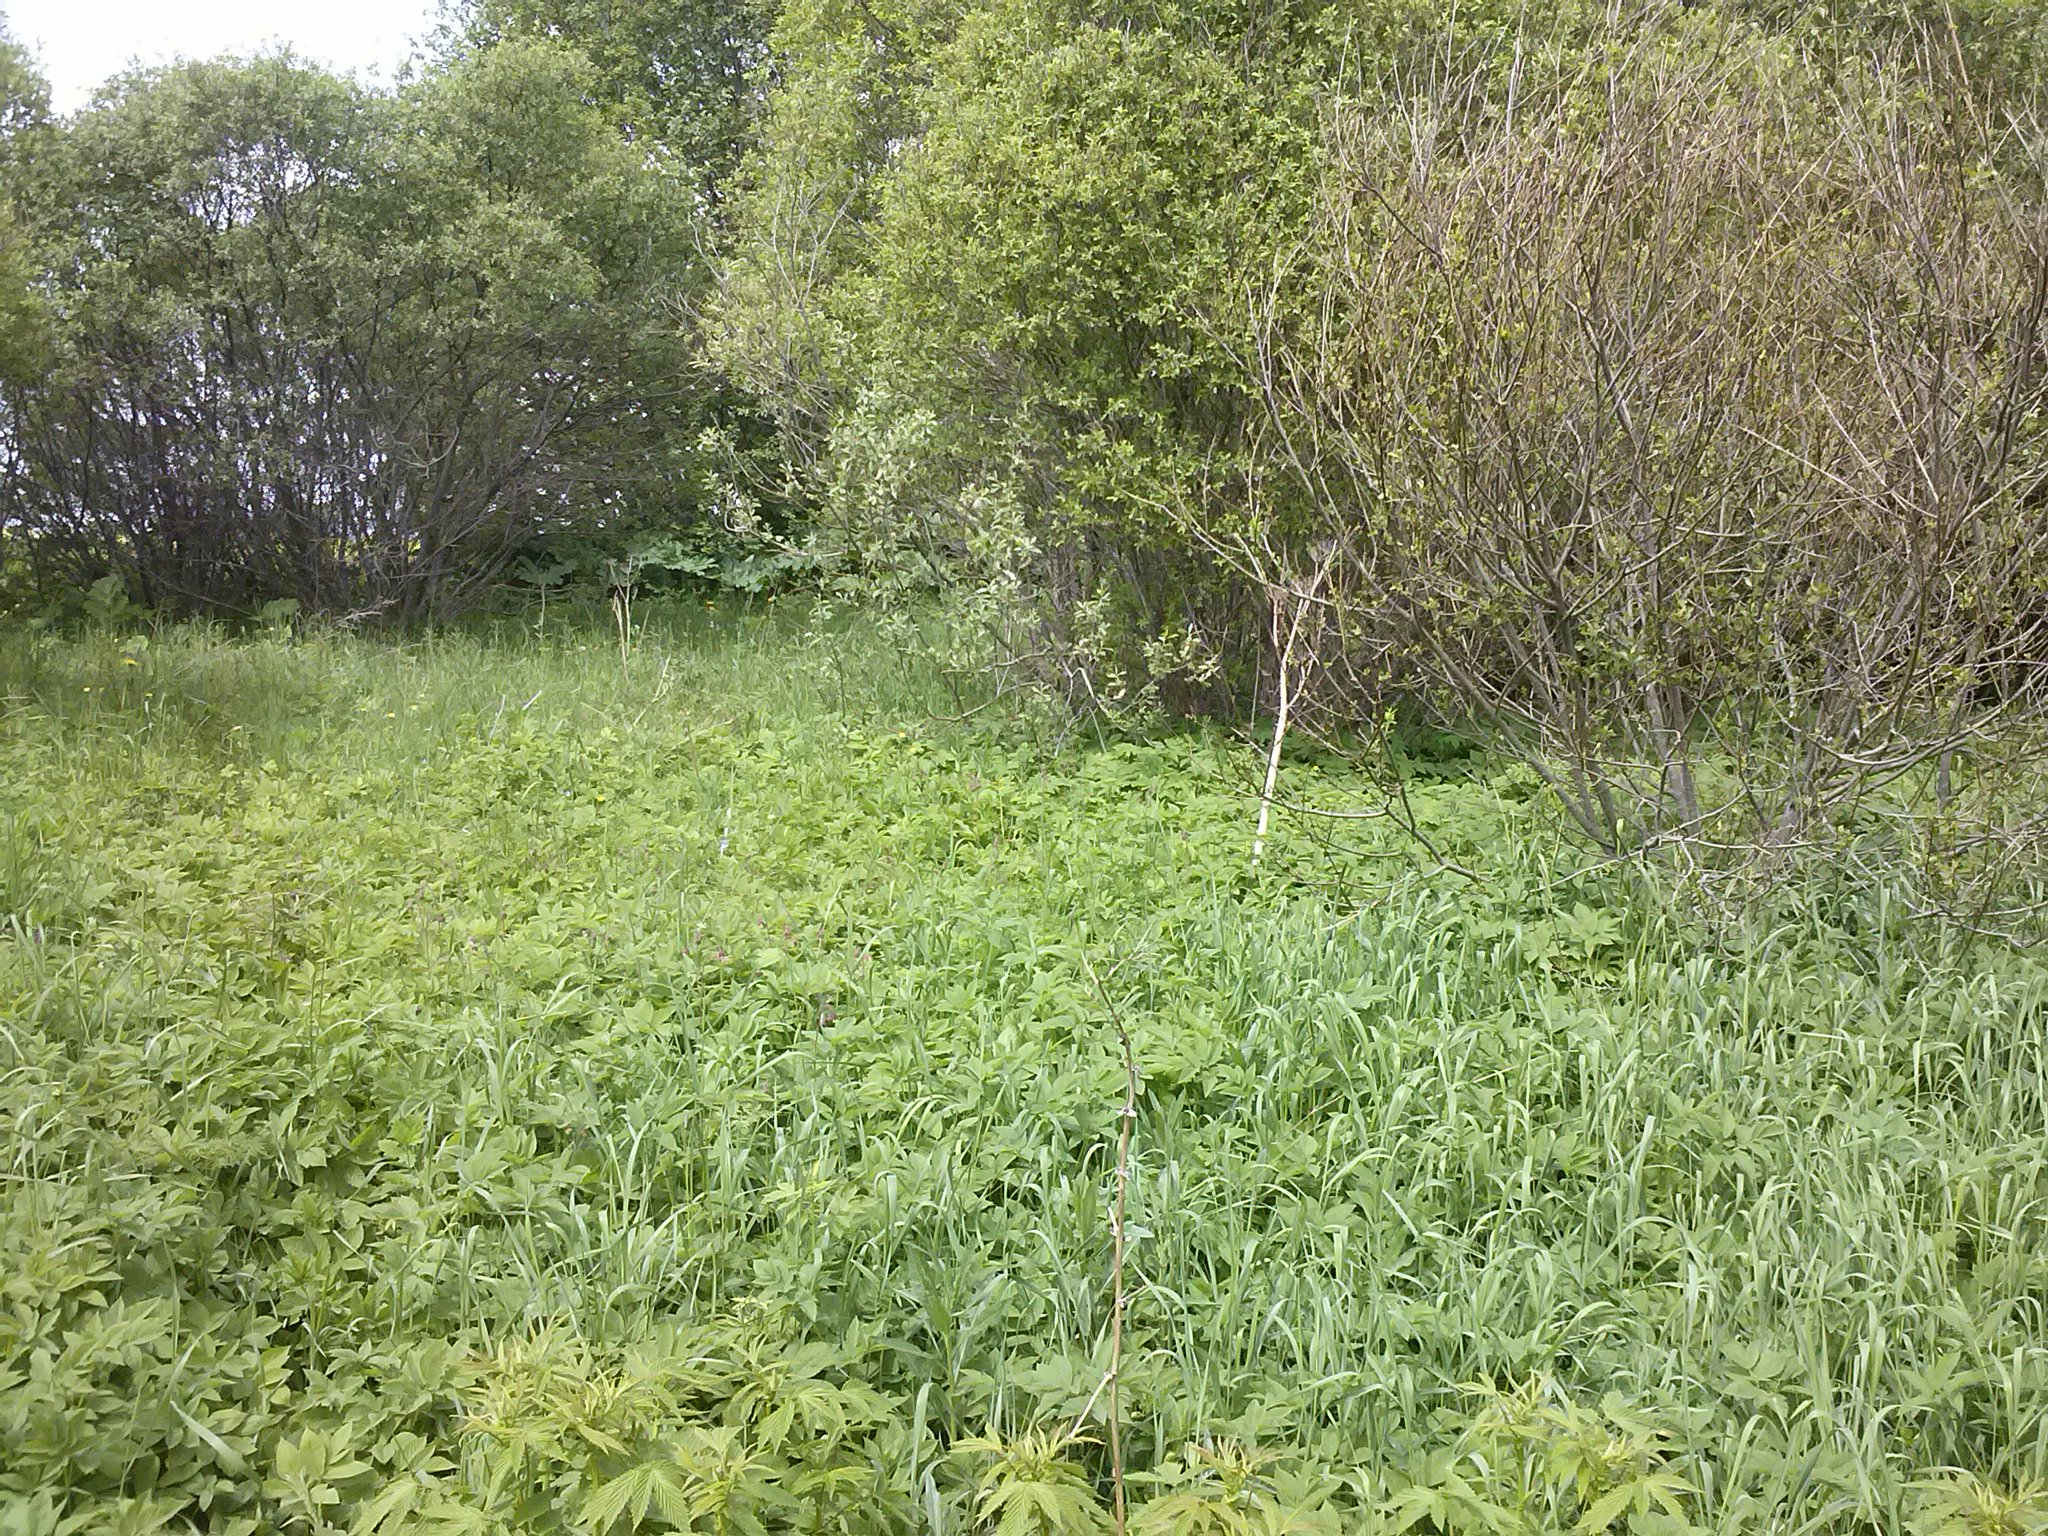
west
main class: Grassland
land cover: Grassland with sparse tree/shrub cover
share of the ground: > 75 %
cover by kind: herbaceous plants 90 %, broadleaved forest trees 5 %, shrubs 5 %
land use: Agriculture (excluding fallow land and kitchen gardens)
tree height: < 5 m
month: May
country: LV
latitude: 56.1706
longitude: 27.7612
